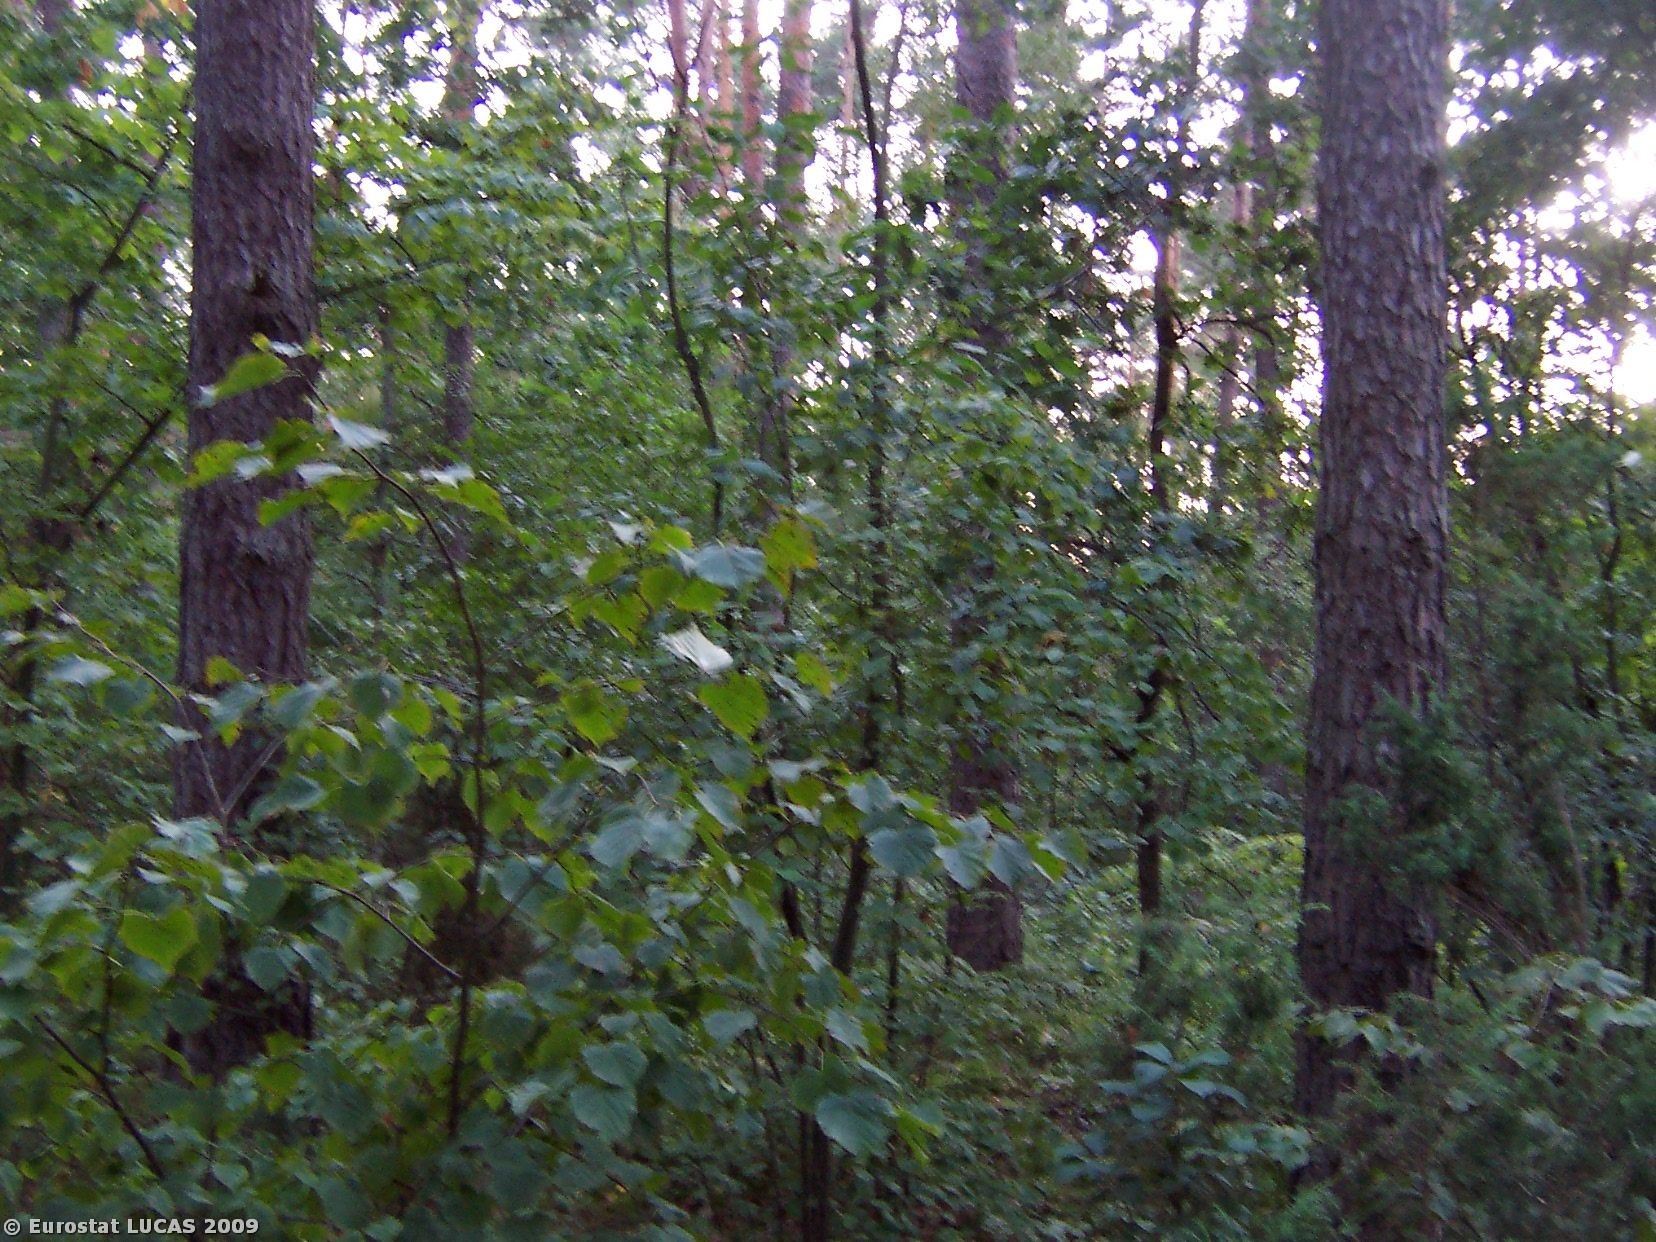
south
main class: Woodland
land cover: Mixed woodland
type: mesophytic deciduous forest
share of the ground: > 75 %
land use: Agriculture (excluding fallow land and kitchen gardens)
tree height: > 5 m
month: August
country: PL
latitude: 52.6935
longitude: 21.8182
